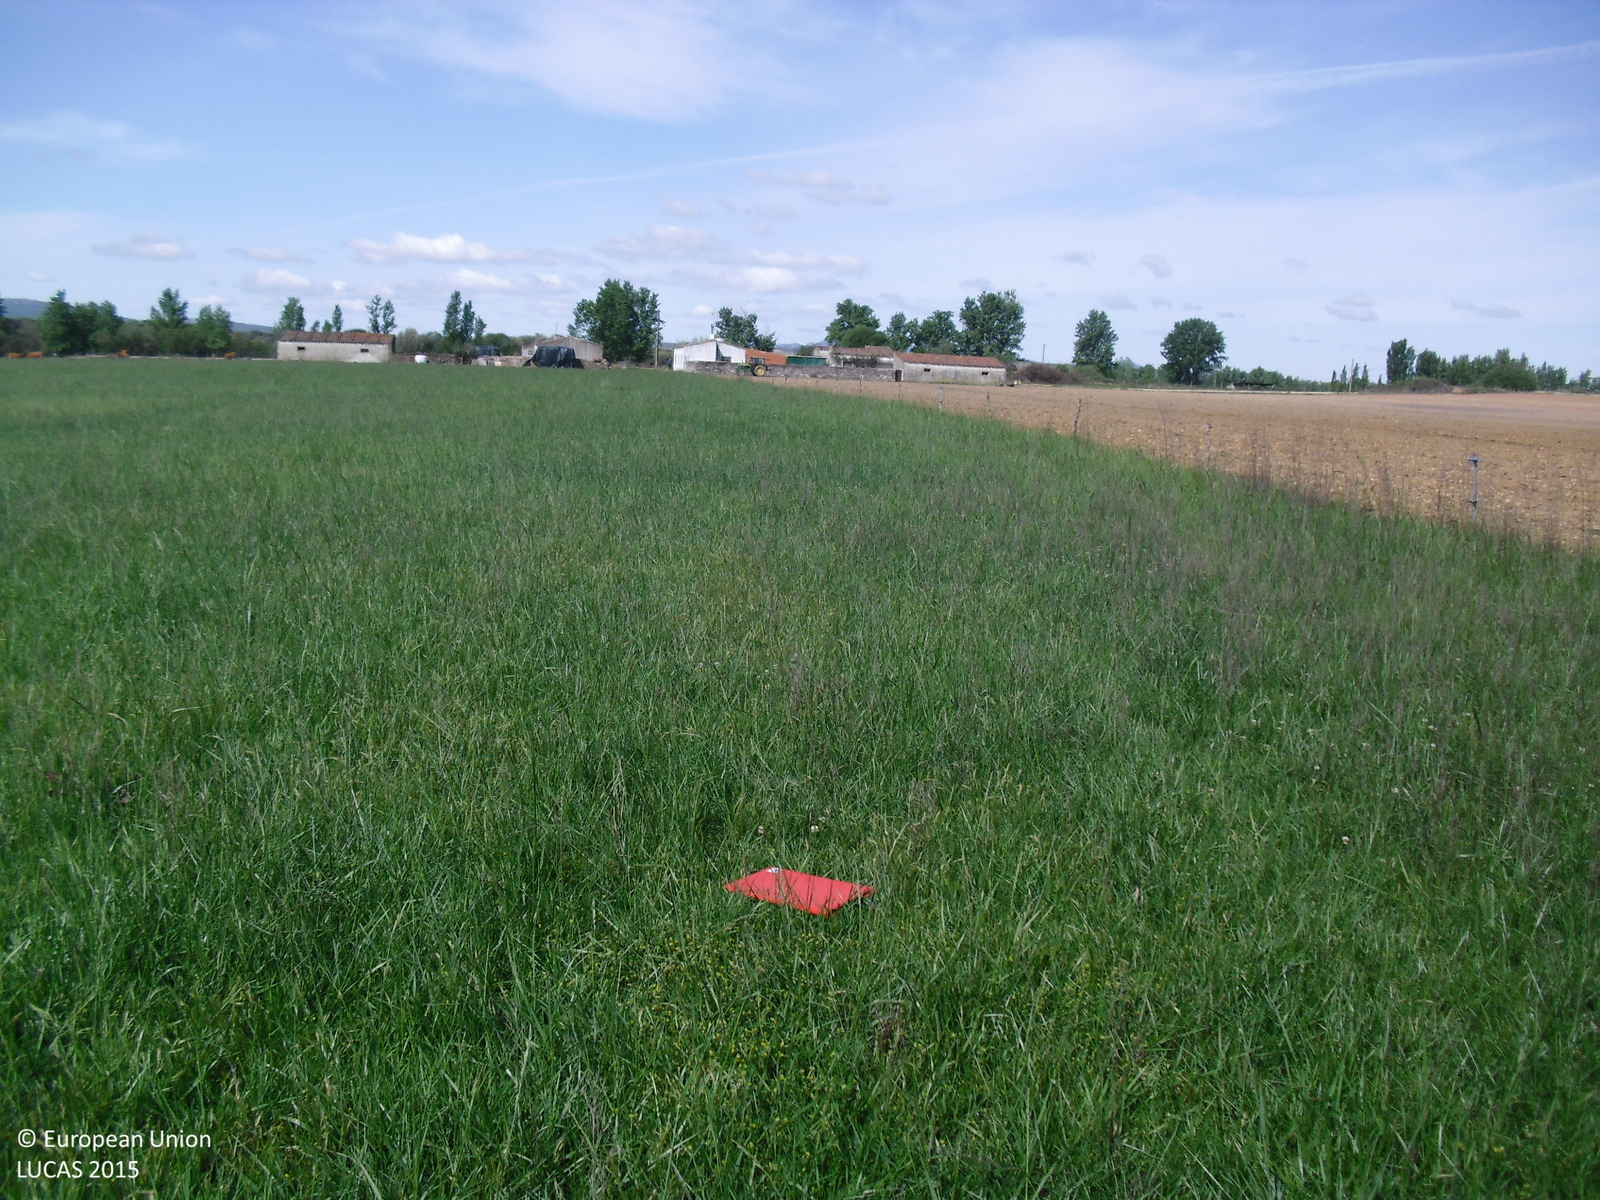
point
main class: Cropland
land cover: Temporary grasslands
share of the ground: > 75 %
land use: Agriculture (excluding fallow land and kitchen gardens)
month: April
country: ES
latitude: 40.0165
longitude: -6.7333
